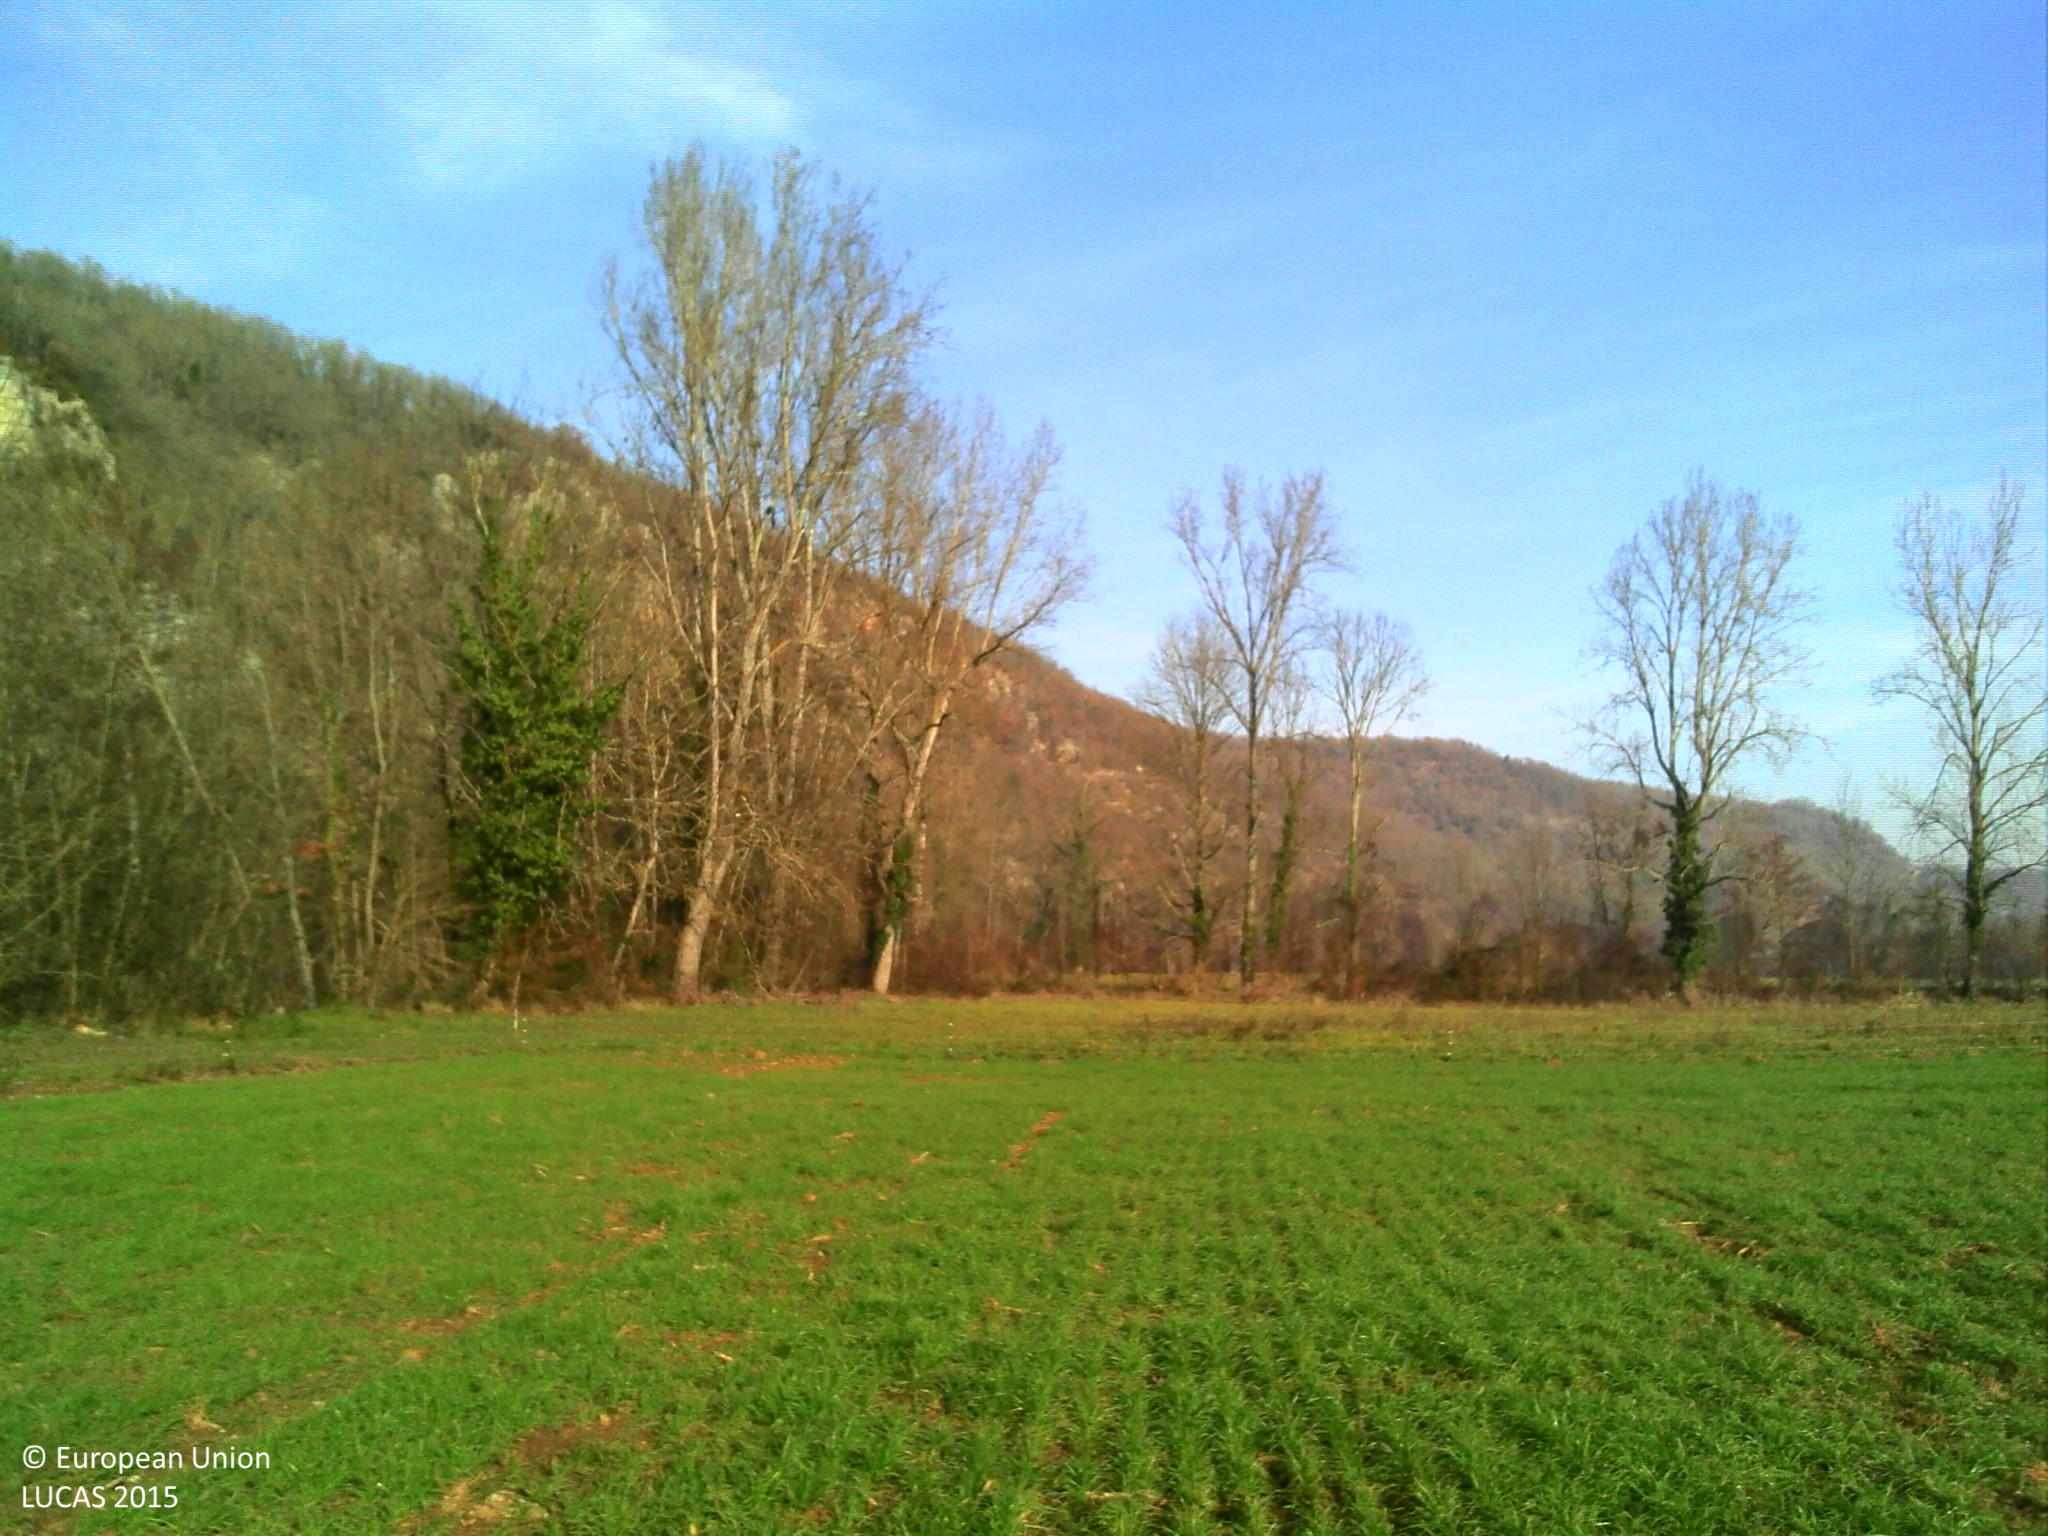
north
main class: Cropland
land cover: Maize
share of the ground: 50 - 75 %
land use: Agriculture (excluding fallow land and kitchen gardens)
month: December
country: FR
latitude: 44.5932
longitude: 1.8745
